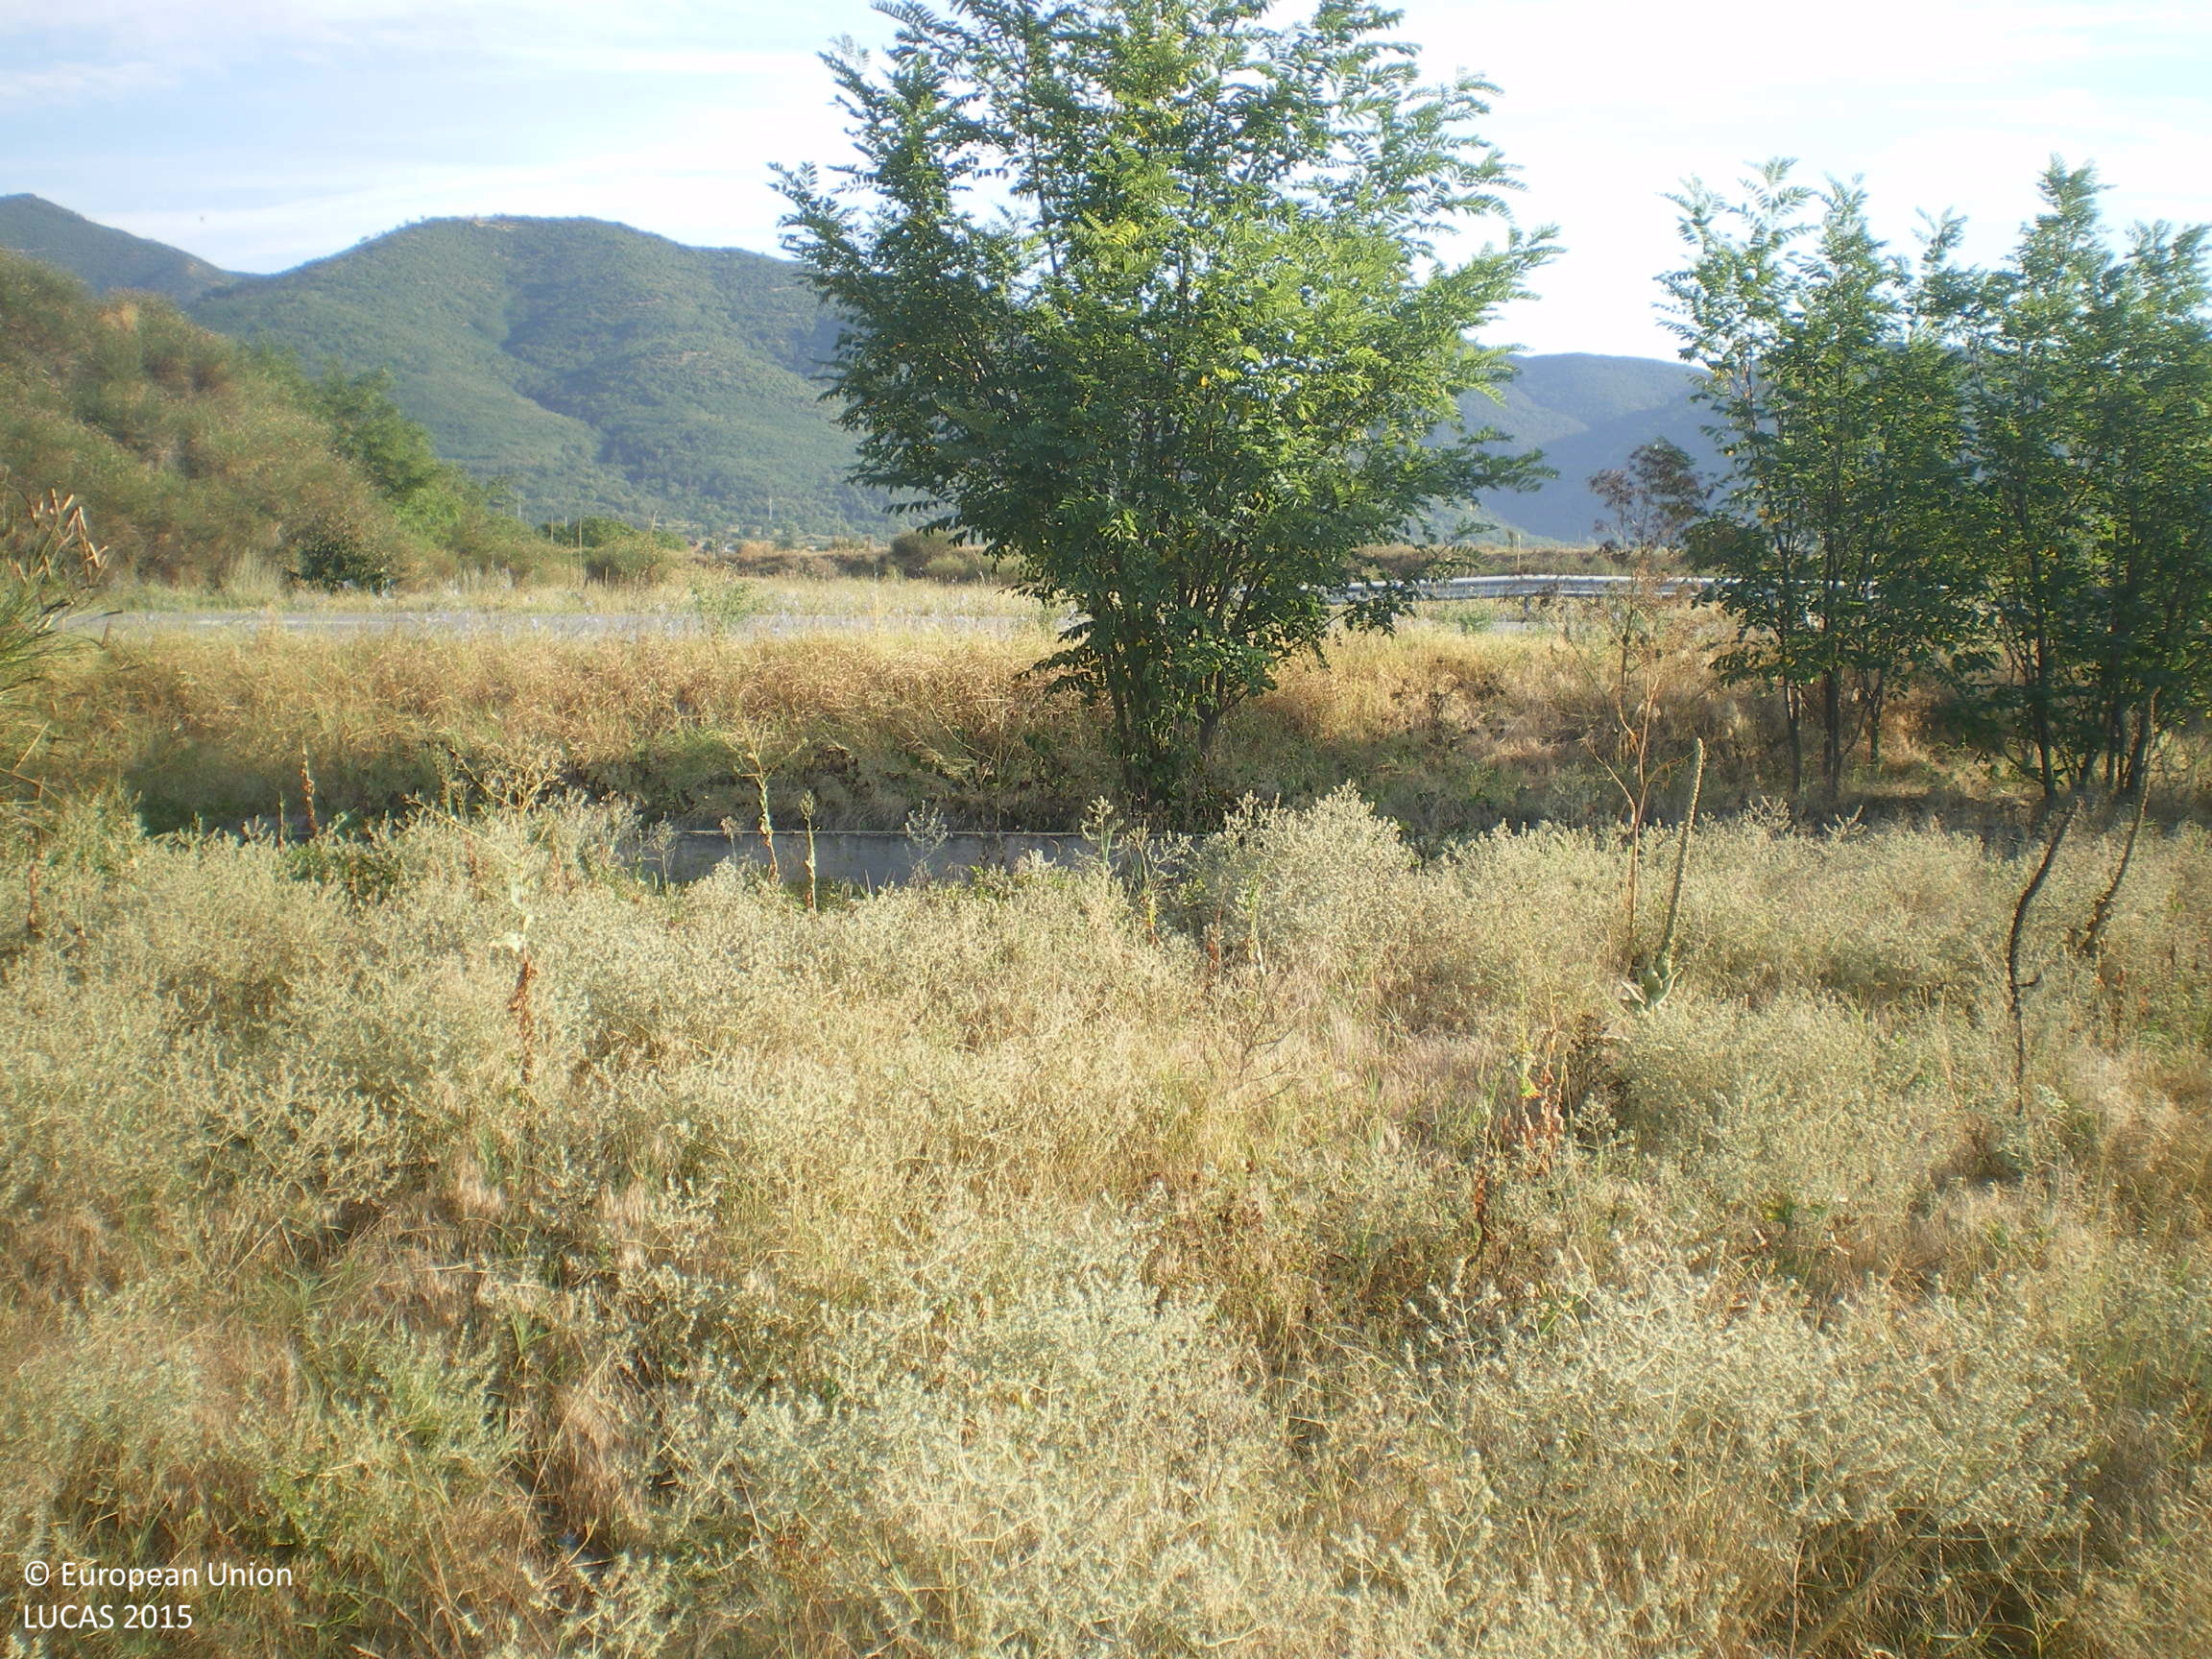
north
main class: Grassland
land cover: Grassland without tree/shrub cover
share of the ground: > 75 %
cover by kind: herbaceous plants 95 %, shrubs 5 %
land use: Road transport
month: August
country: BG
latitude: 42.6053
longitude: 25.6397
